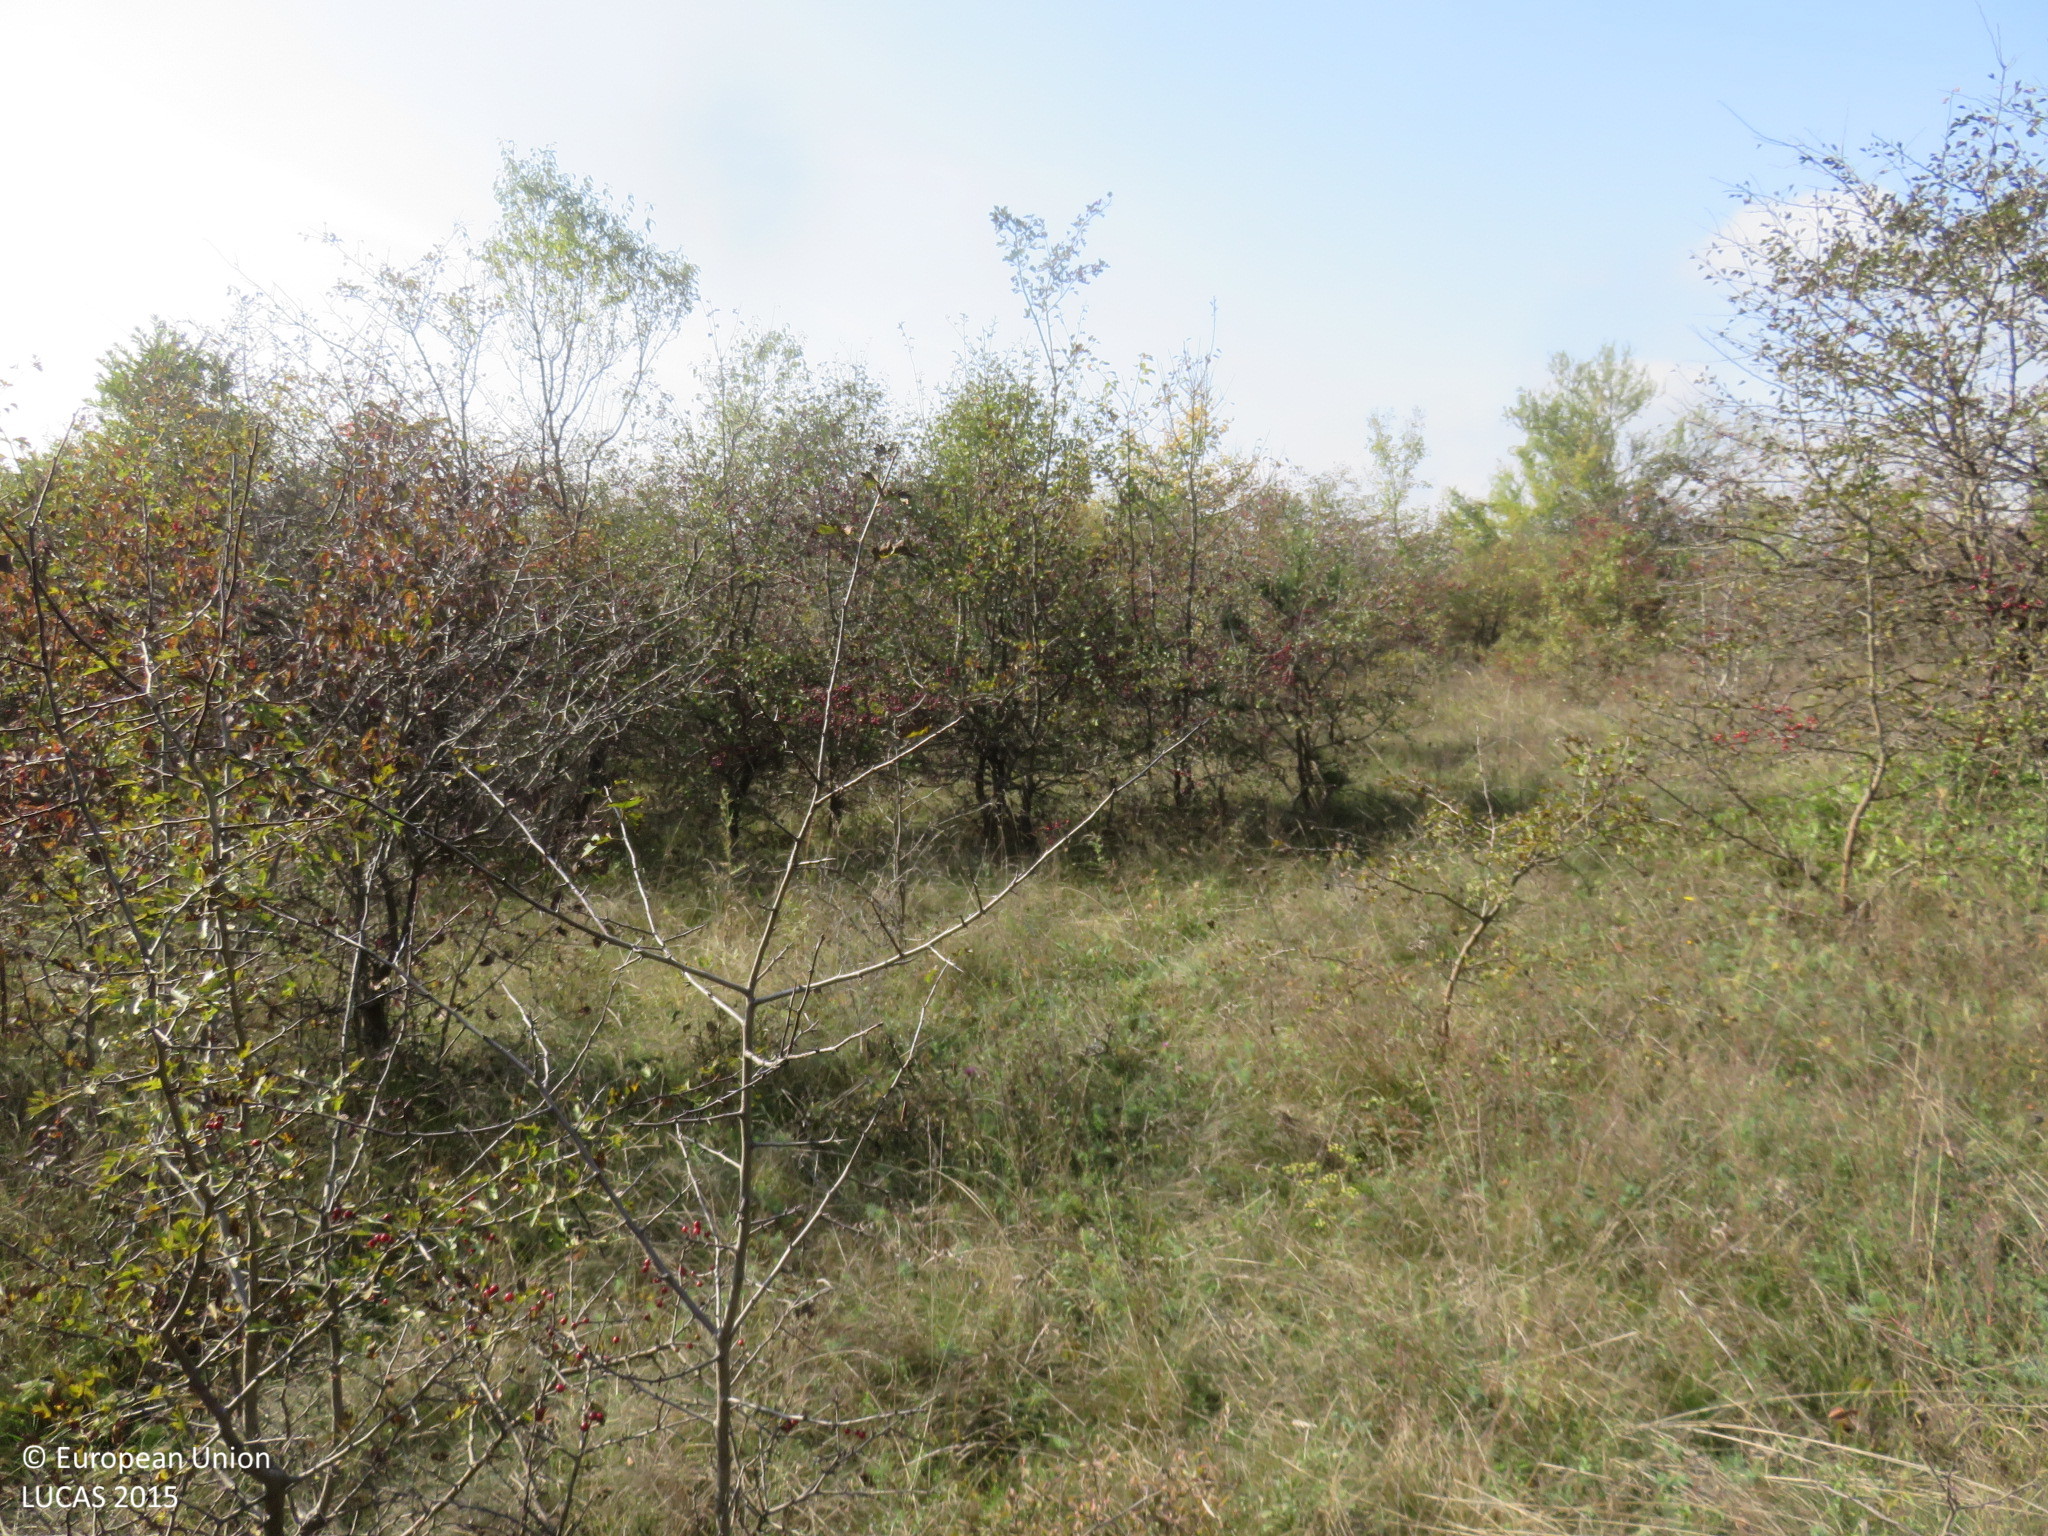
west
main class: Shrubland
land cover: Shrubland with sparse tree cover
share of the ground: > 75 %
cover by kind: shrubs 80 %, herbaceous plants 15 %, broadleaved forest trees 5 %
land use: Semi-natural and natural areas not in use
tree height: < 5 m
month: October
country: BG
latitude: 42.9891
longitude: 25.2919
